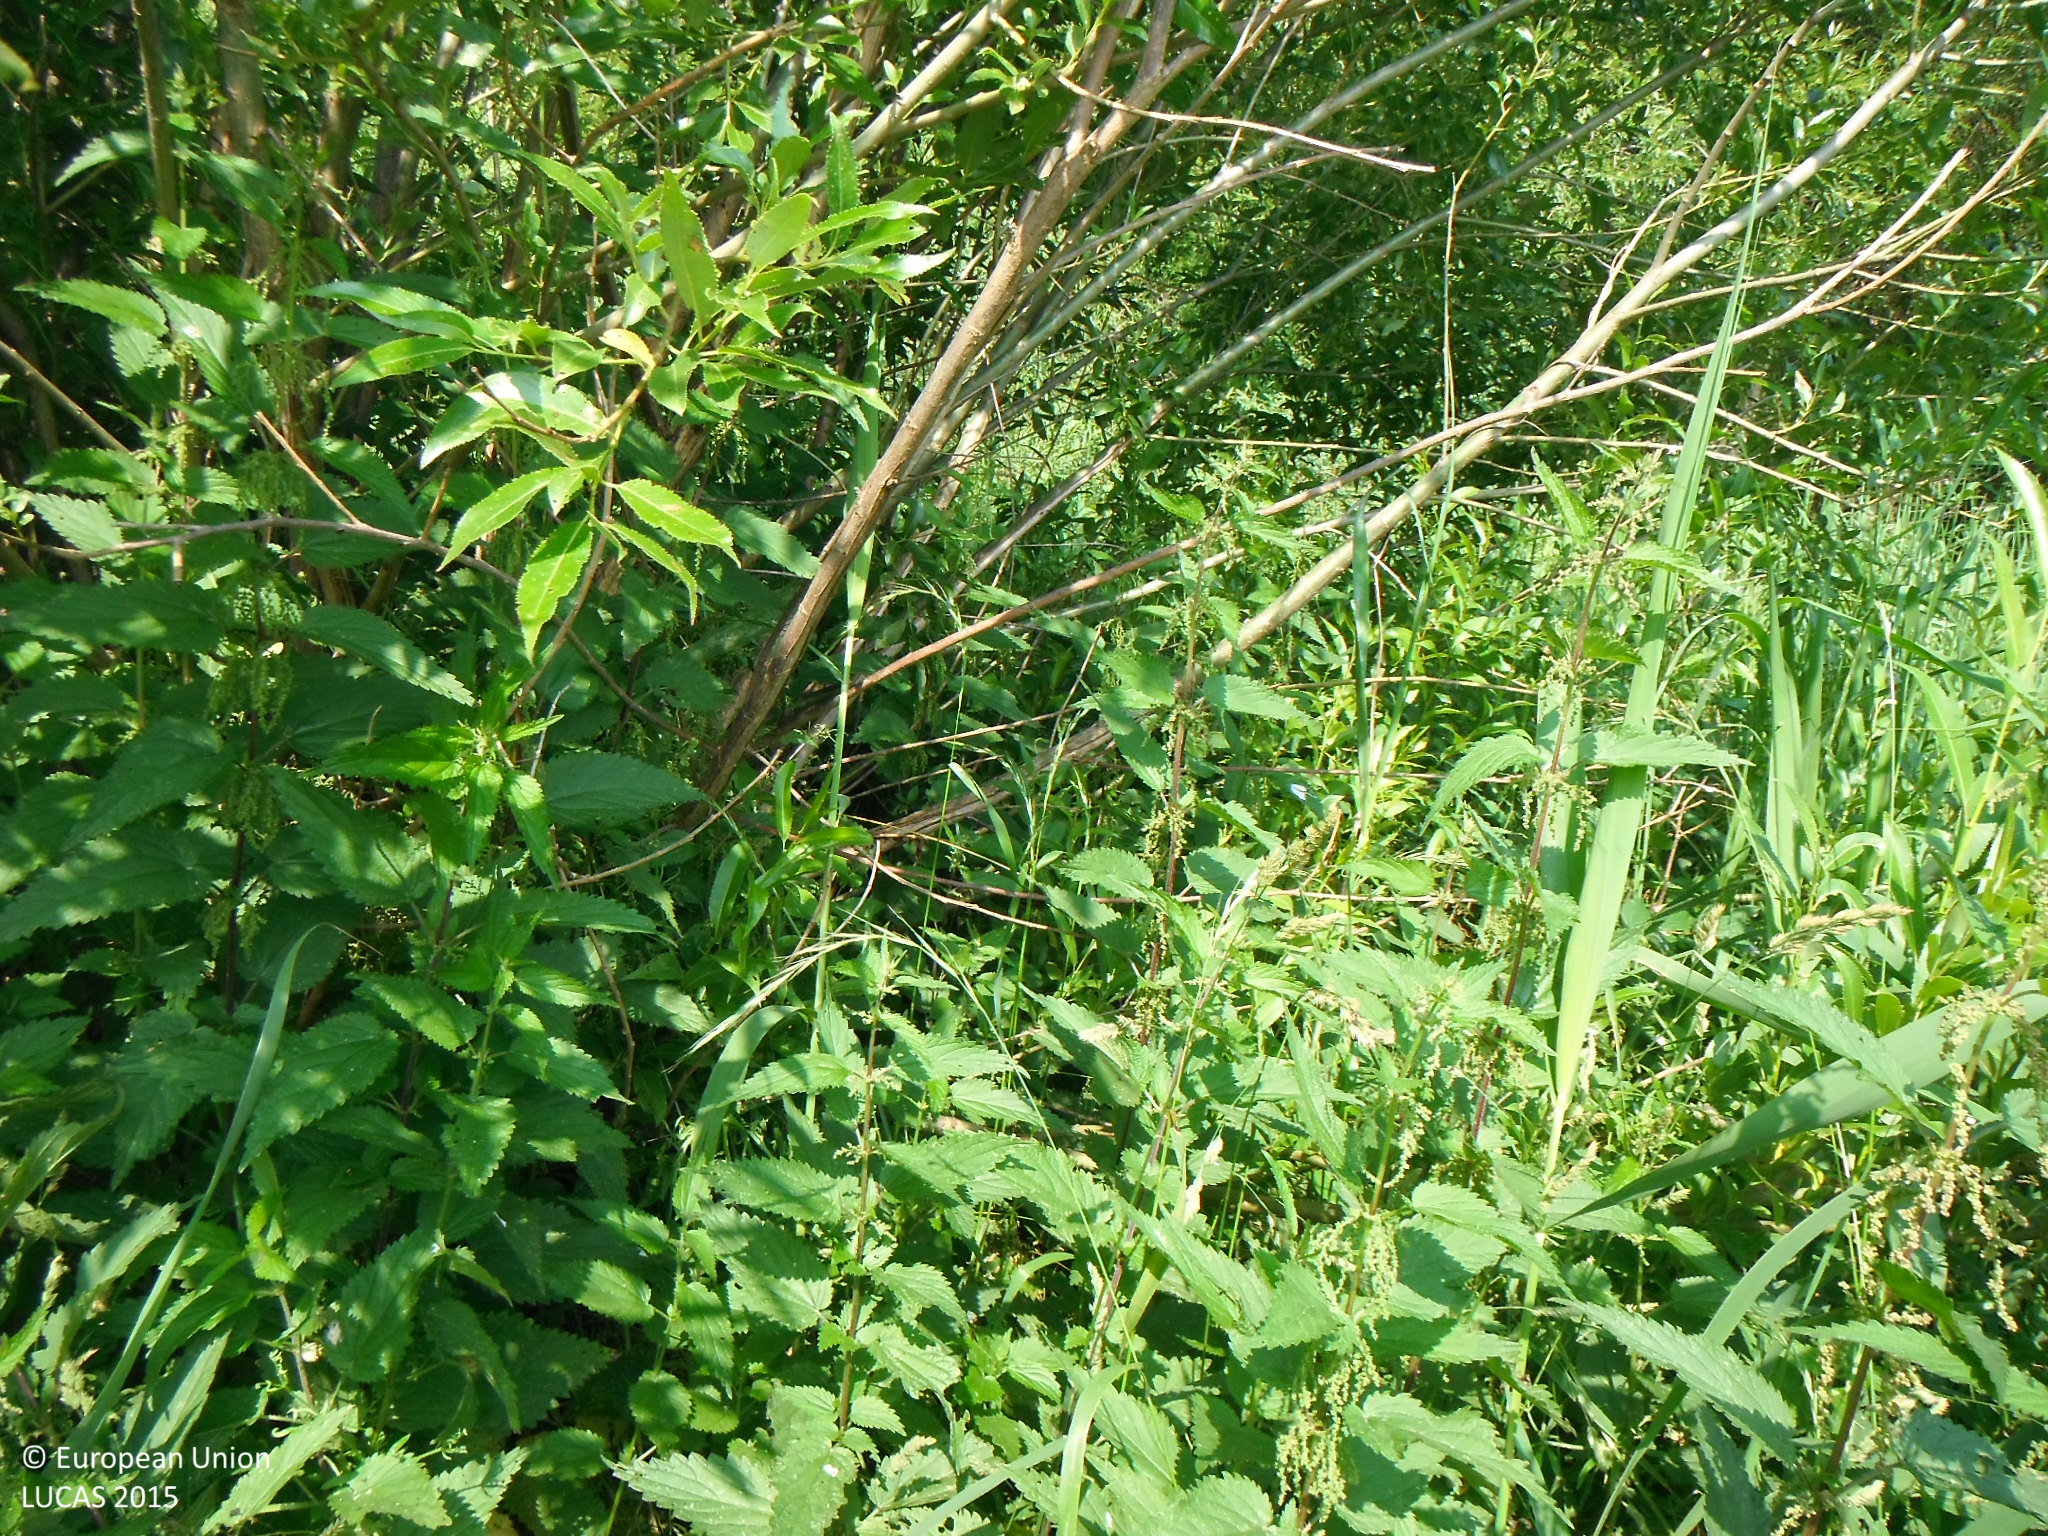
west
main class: Grassland
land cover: Spontaneously vegetated surfaces
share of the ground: > 75 %
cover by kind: herbaceous plants 100 %
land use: Semi-natural and natural areas not in use
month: July
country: SK
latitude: 49.1242
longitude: 19.4119
